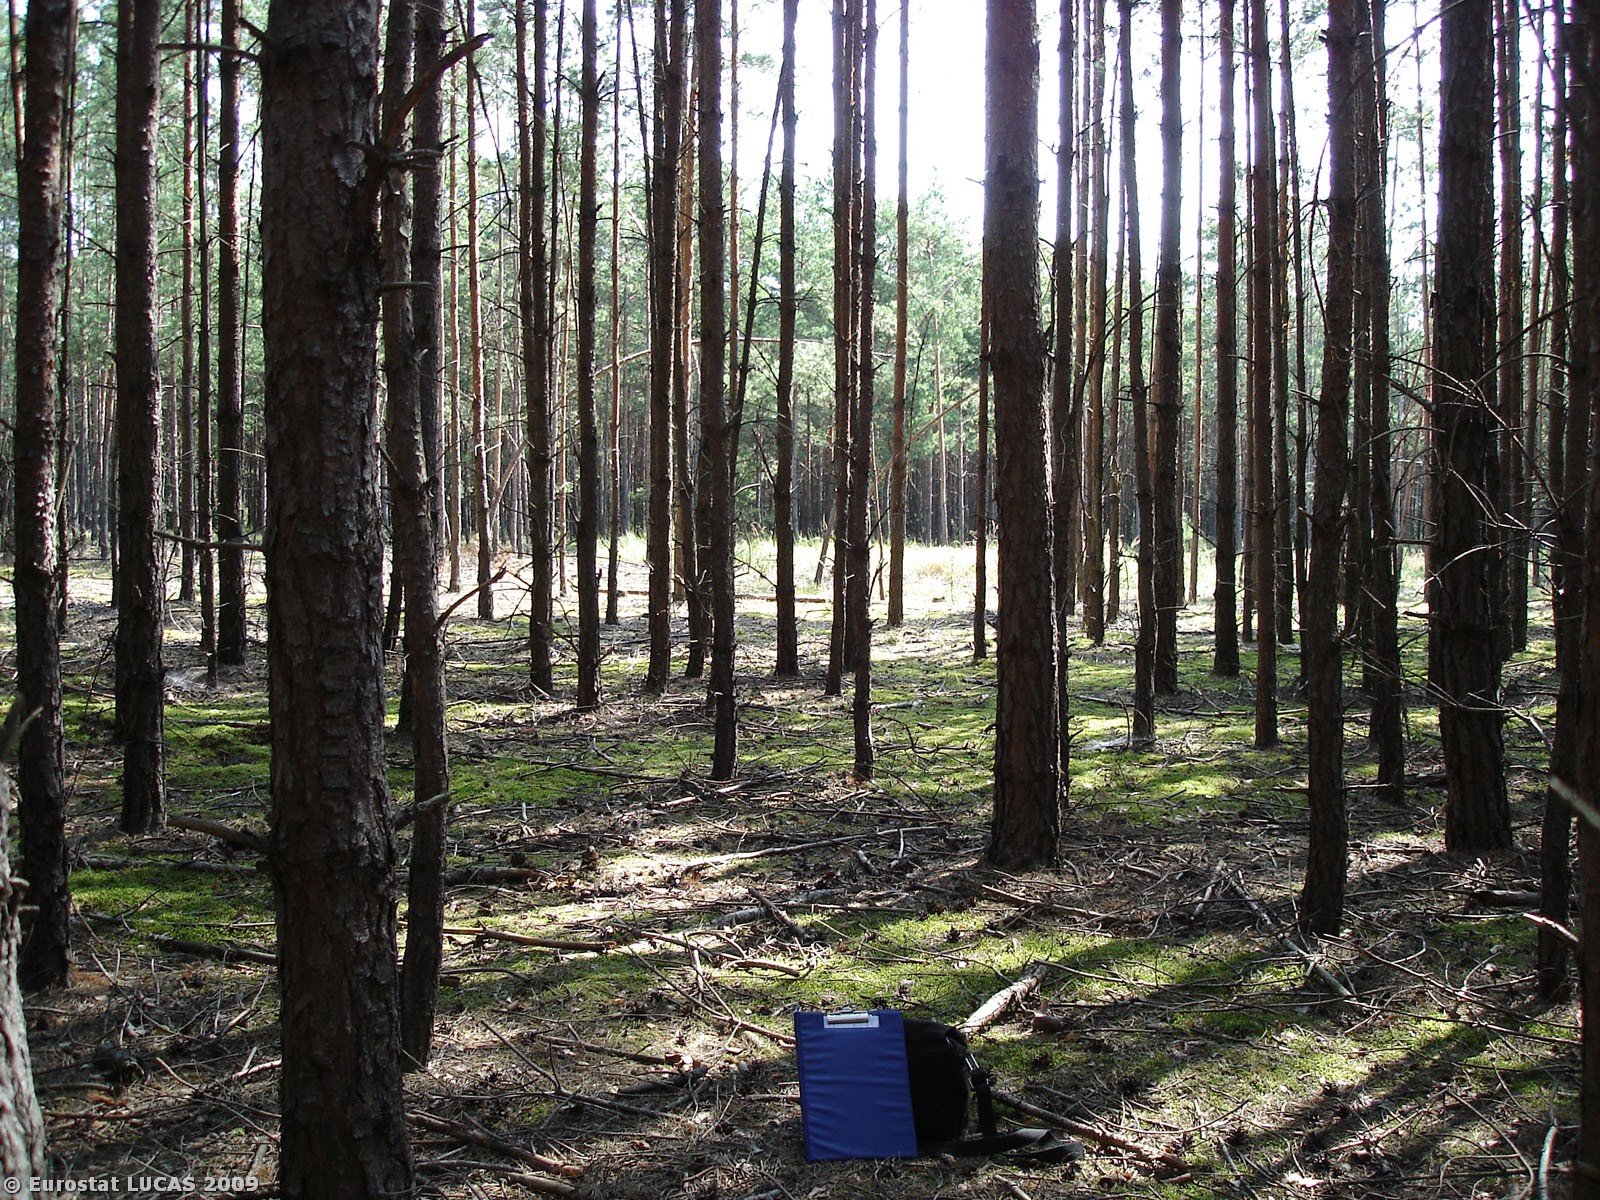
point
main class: Woodland
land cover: Coniferous woodland
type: hemiboreal forest and nemoral coniferous forest and mixed broadleaved-coniferous forest
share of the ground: > 75 %
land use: Forestry
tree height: > 5 m
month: August
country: PL
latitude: 51.0136
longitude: 18.8740
